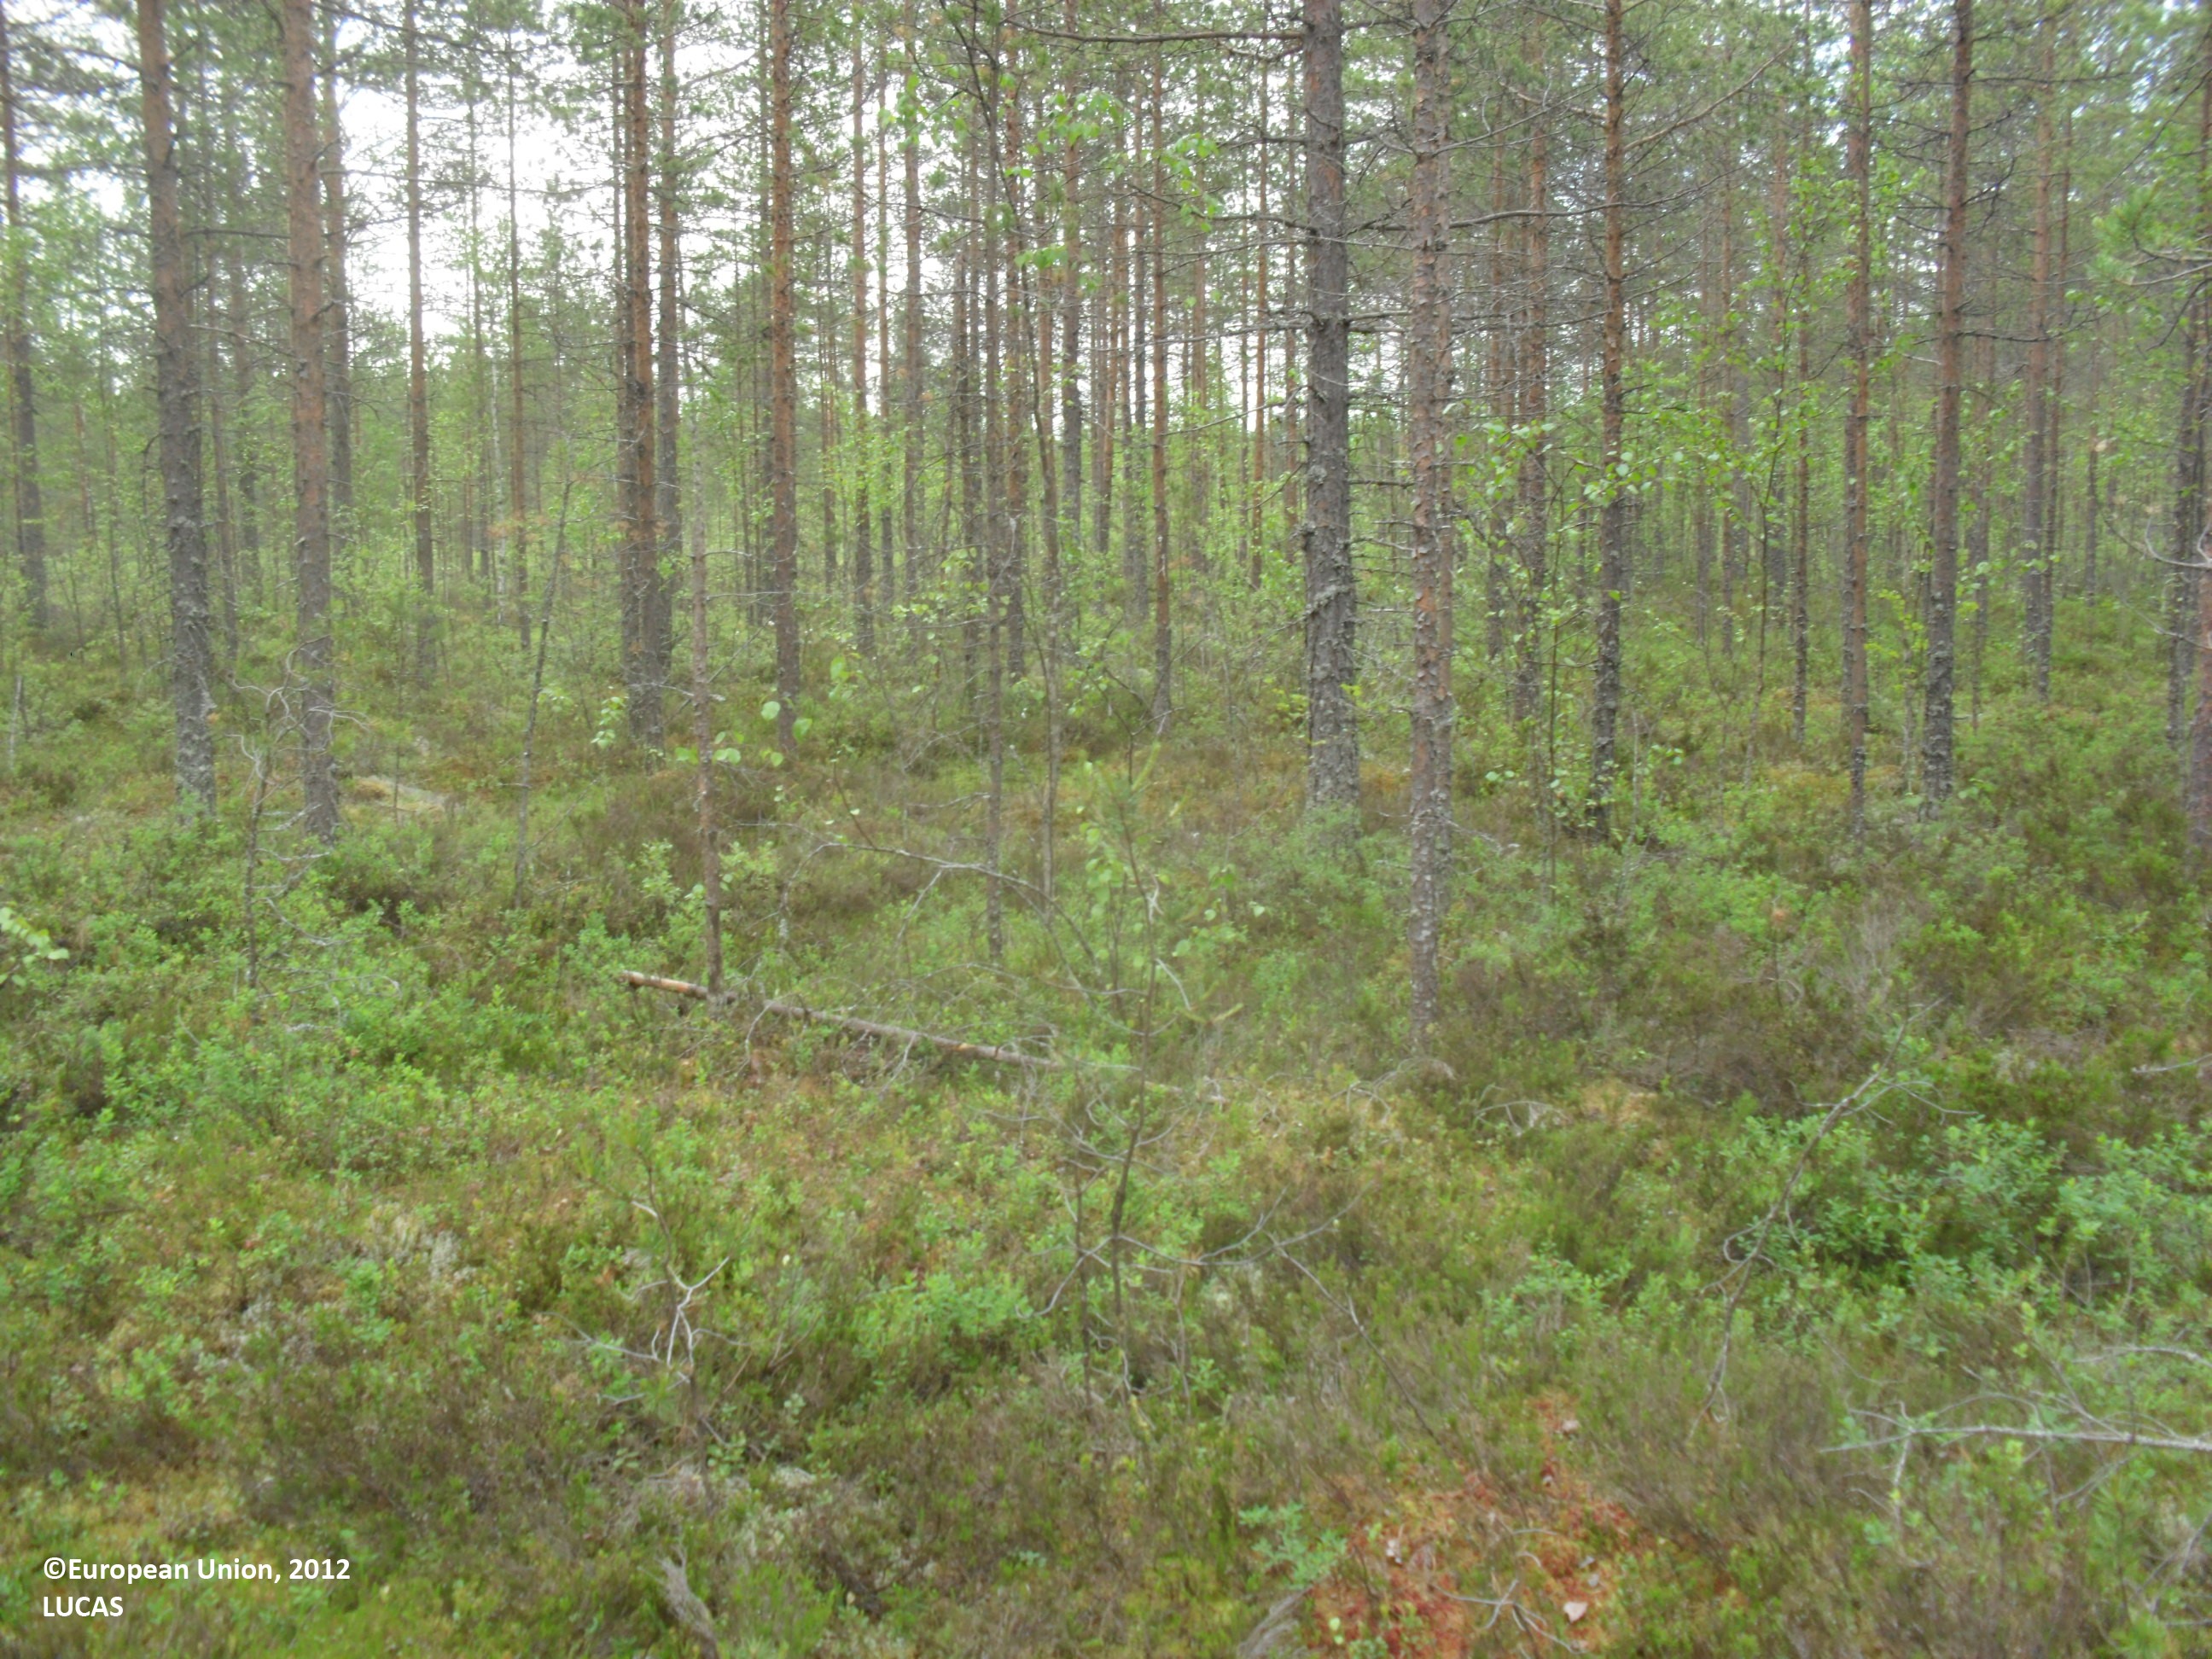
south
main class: Woodland
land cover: Pine dominated coniferous woodland
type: boreal forest
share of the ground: 25 - 50 %
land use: Forestry
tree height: > 5 m
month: June
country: FI
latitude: 62.8431
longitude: 23.7205
